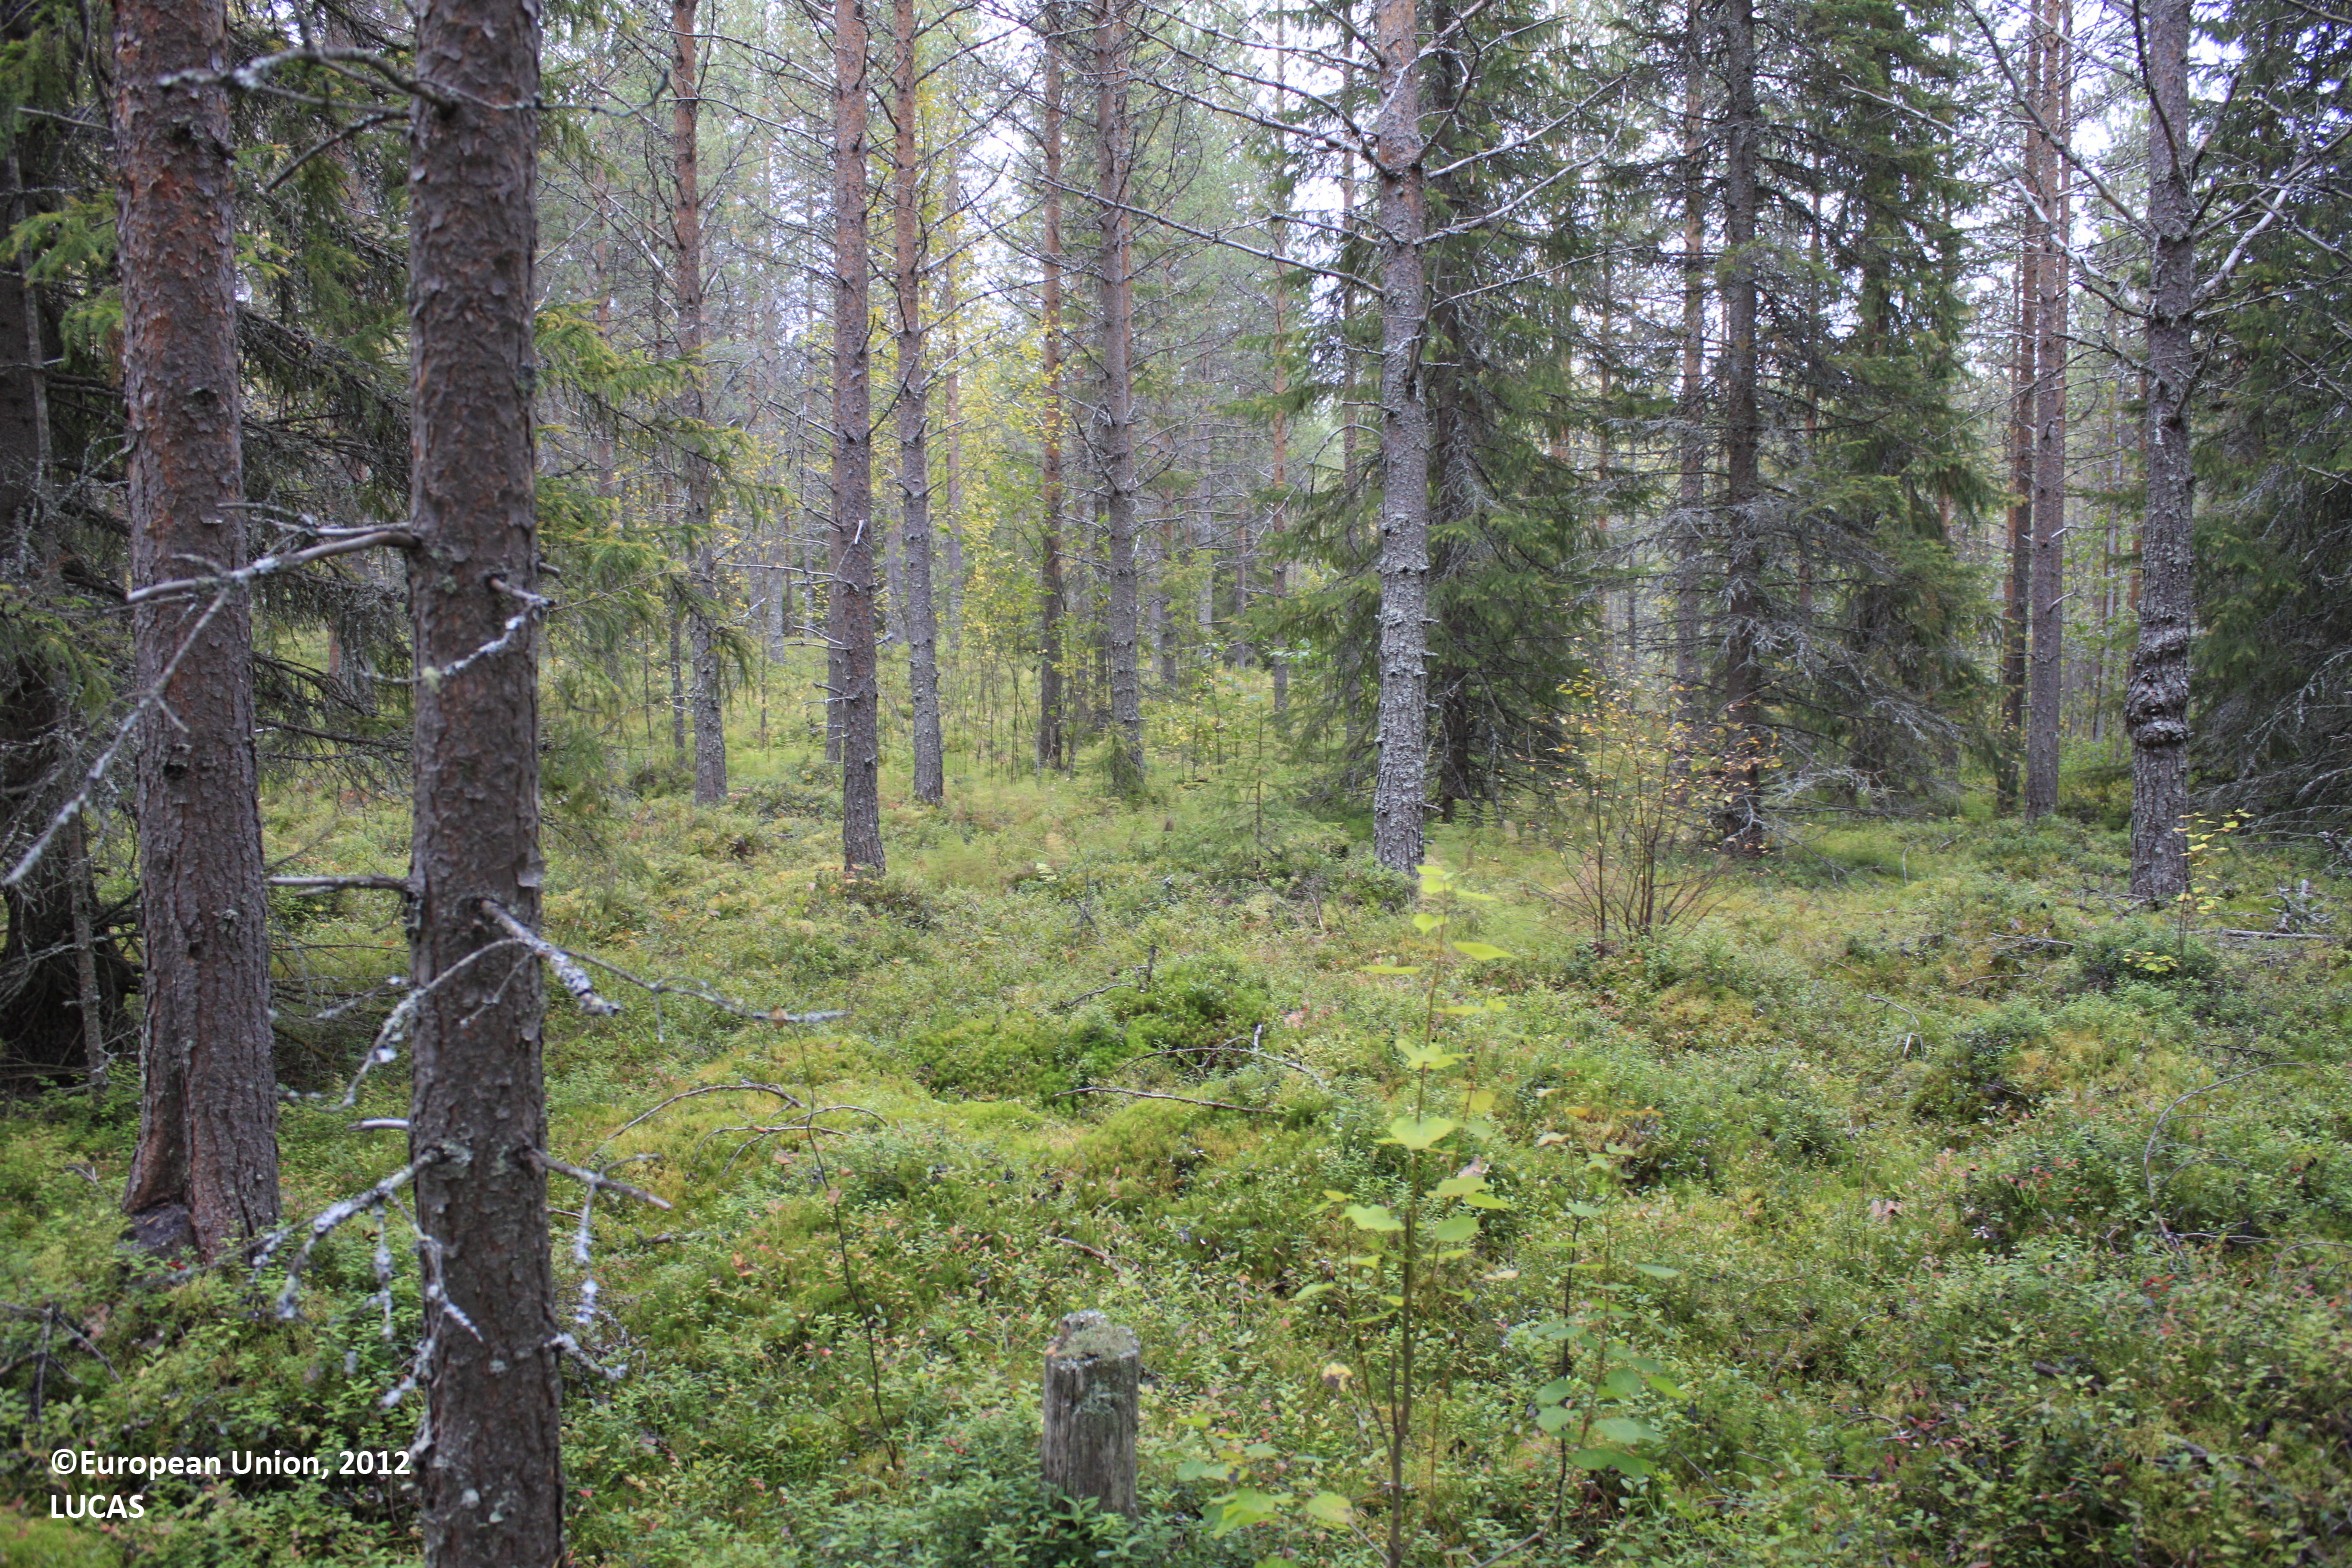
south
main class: Woodland
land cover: Pine dominated coniferous woodland
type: boreal forest
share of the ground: 50 - 75 %
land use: Forestry
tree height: > 5 m
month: September
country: FI
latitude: 65.5451
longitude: 27.2451
